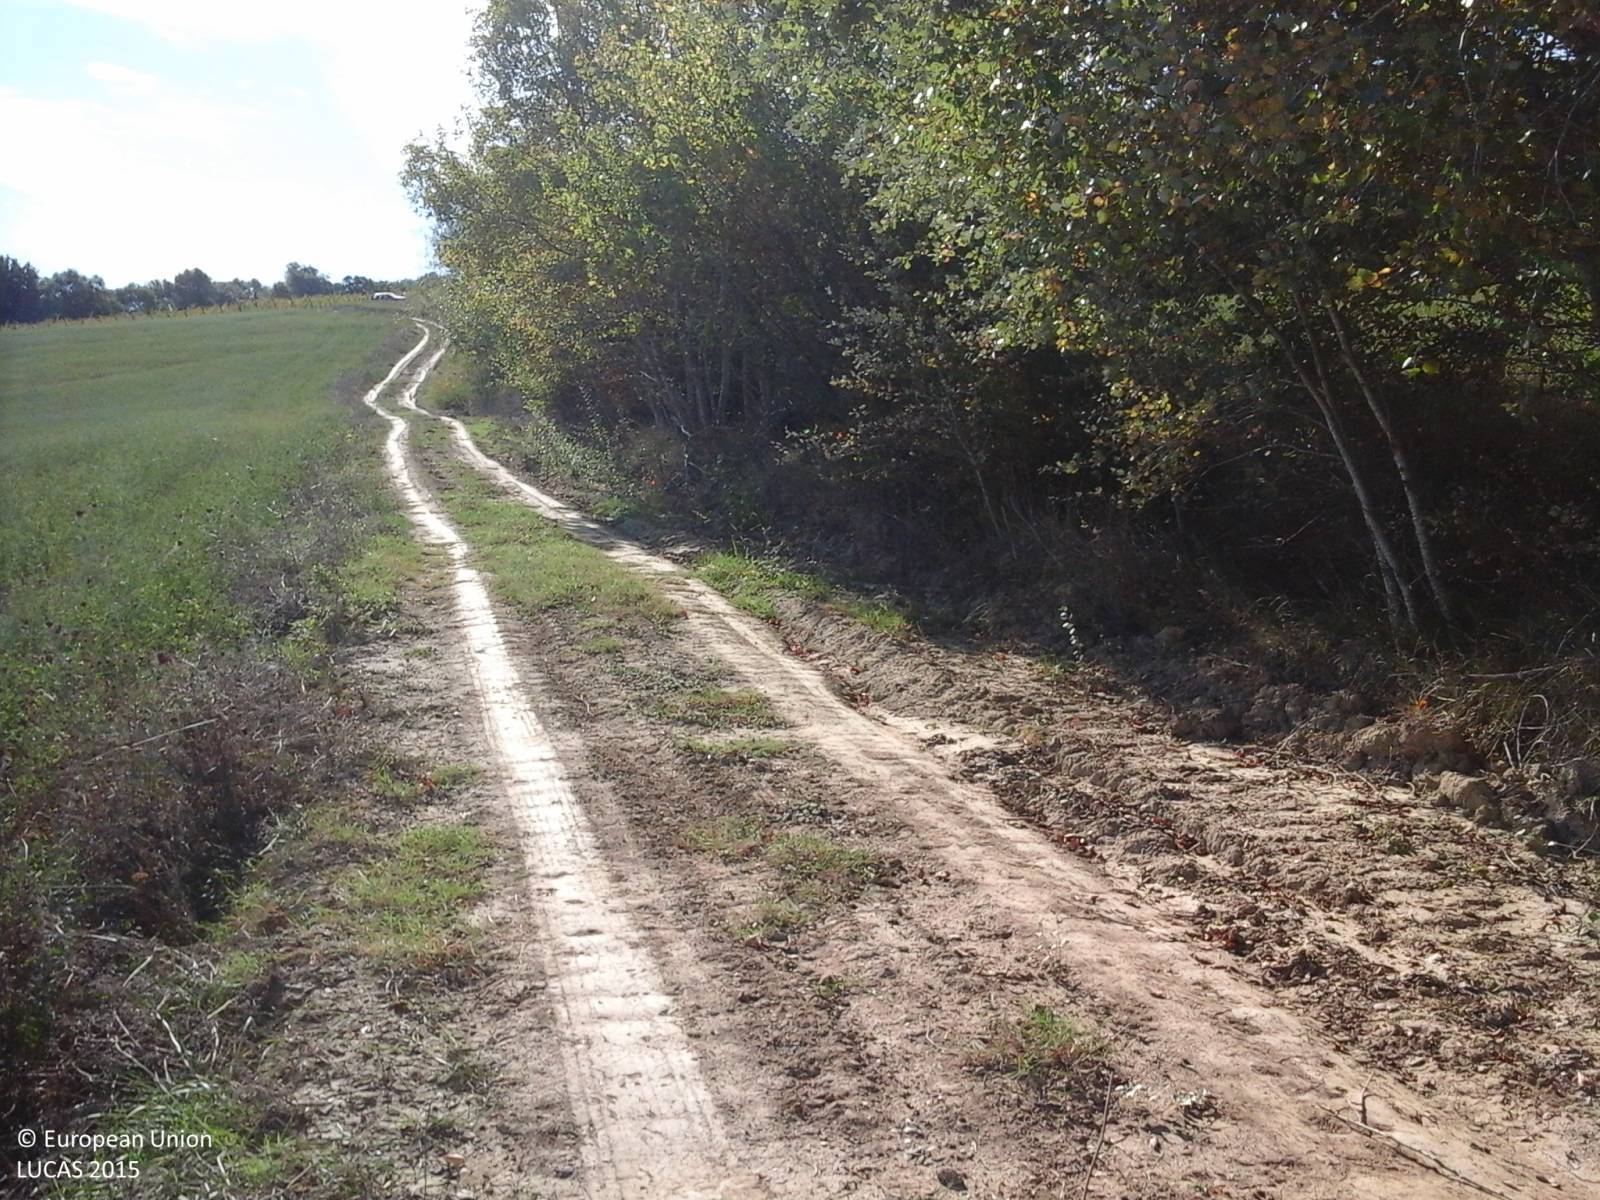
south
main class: Cropland
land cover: Lucerne
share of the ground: > 75 %
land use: Agriculture (excluding fallow land and kitchen gardens)
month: September
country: IT
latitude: 42.4813
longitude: 12.3885
